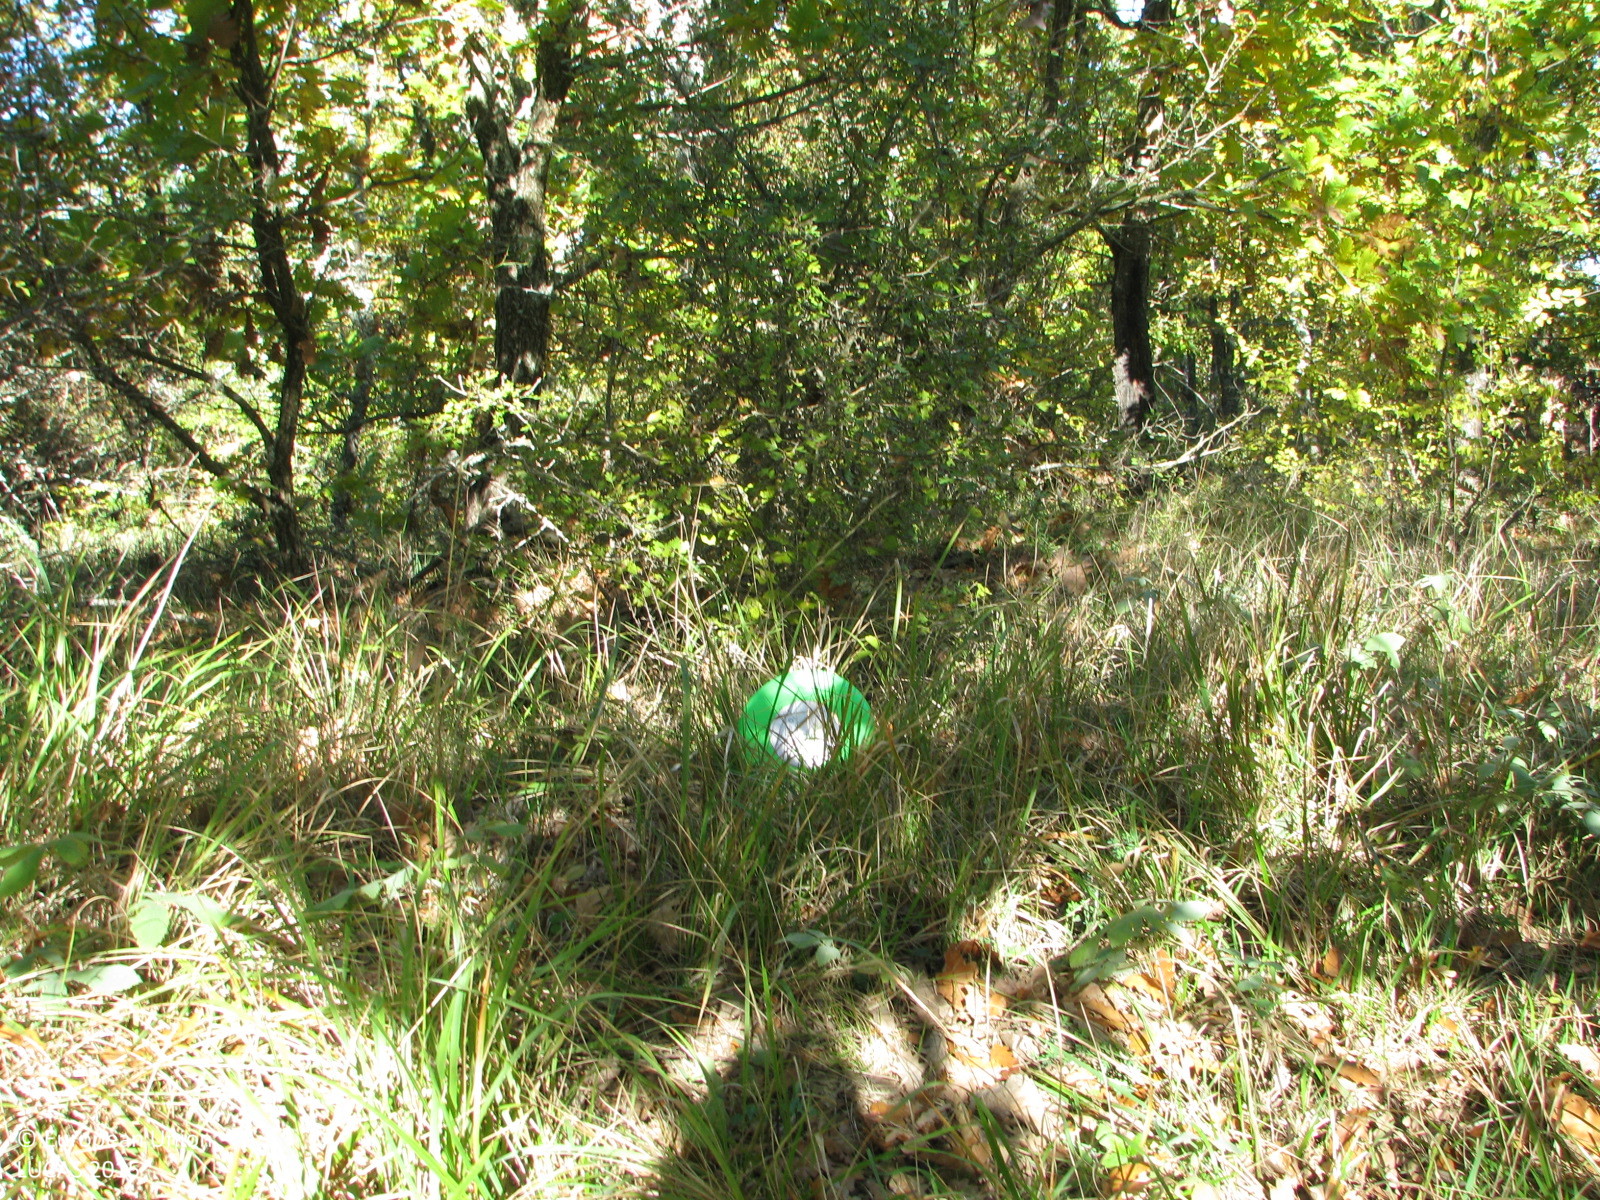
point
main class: Woodland
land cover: Broadleaved woodland
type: acidophilous oak and oak-birch forest
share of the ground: 50 - 75 %
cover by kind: broadleaved forest trees 60 %, herbaceous plants 30 %, shrubs 10 %
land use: Forestry
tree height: < 5 m
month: November
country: BG
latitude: 42.0196
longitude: 26.6463
